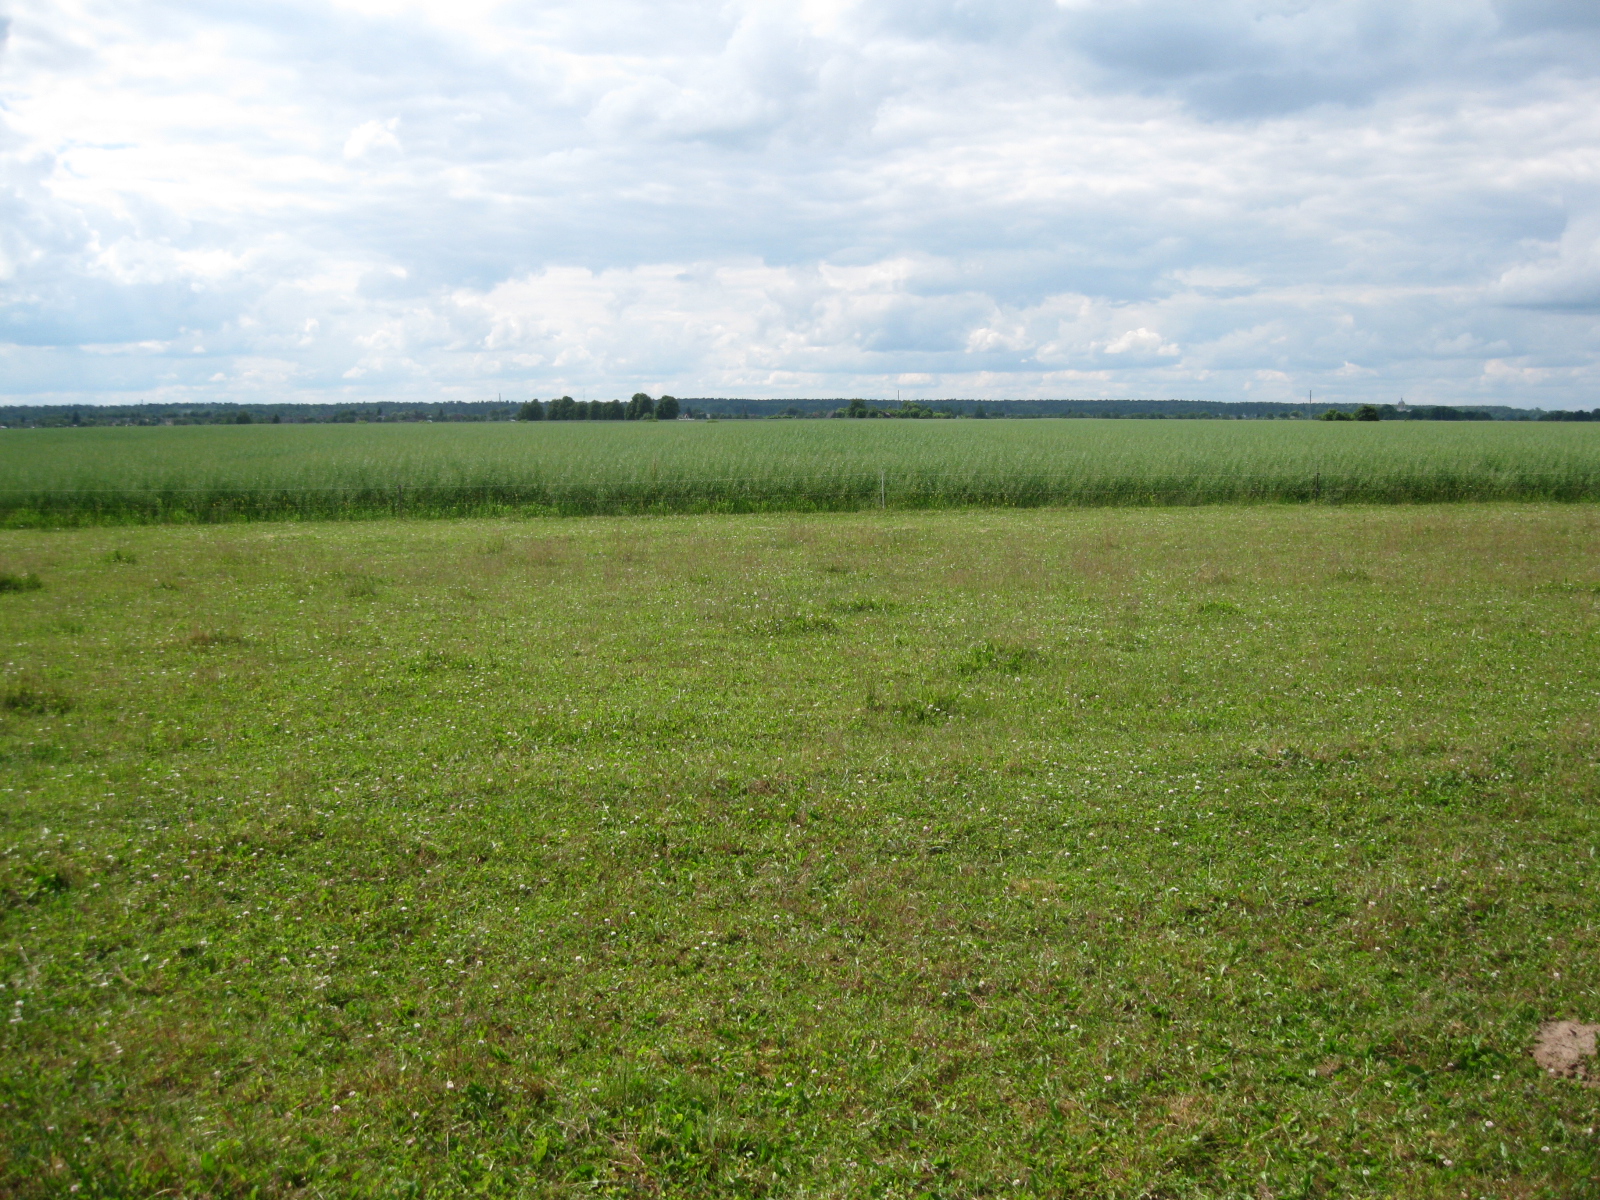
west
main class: Grassland
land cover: Grassland without tree/shrub cover
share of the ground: > 75 %
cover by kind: herbaceous plants 100 %
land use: Agriculture (excluding fallow land and kitchen gardens)
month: June
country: LT
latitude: 55.3194
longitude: 24.0369
